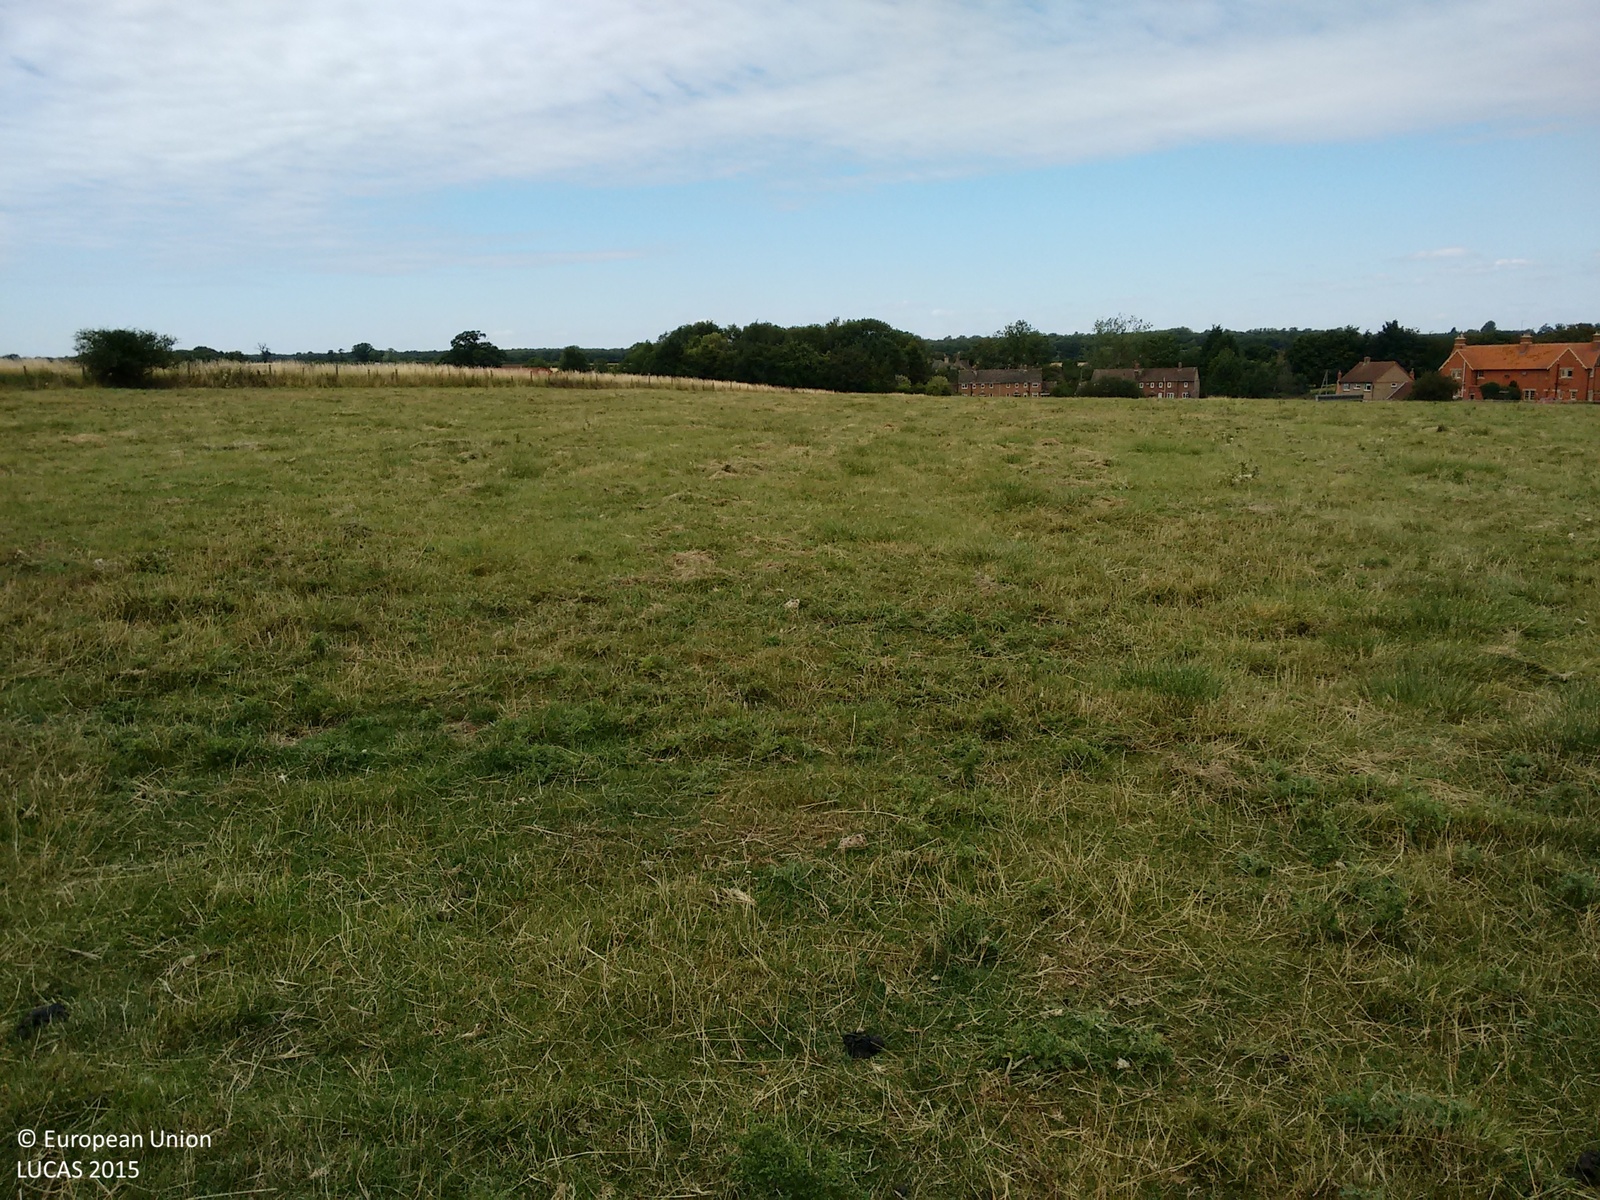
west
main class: Grassland
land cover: Grassland without tree/shrub cover
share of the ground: > 75 %
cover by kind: herbaceous plants 100 %
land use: Agriculture (excluding fallow land and kitchen gardens)
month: August
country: GB
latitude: 52.1975
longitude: -0.7359
